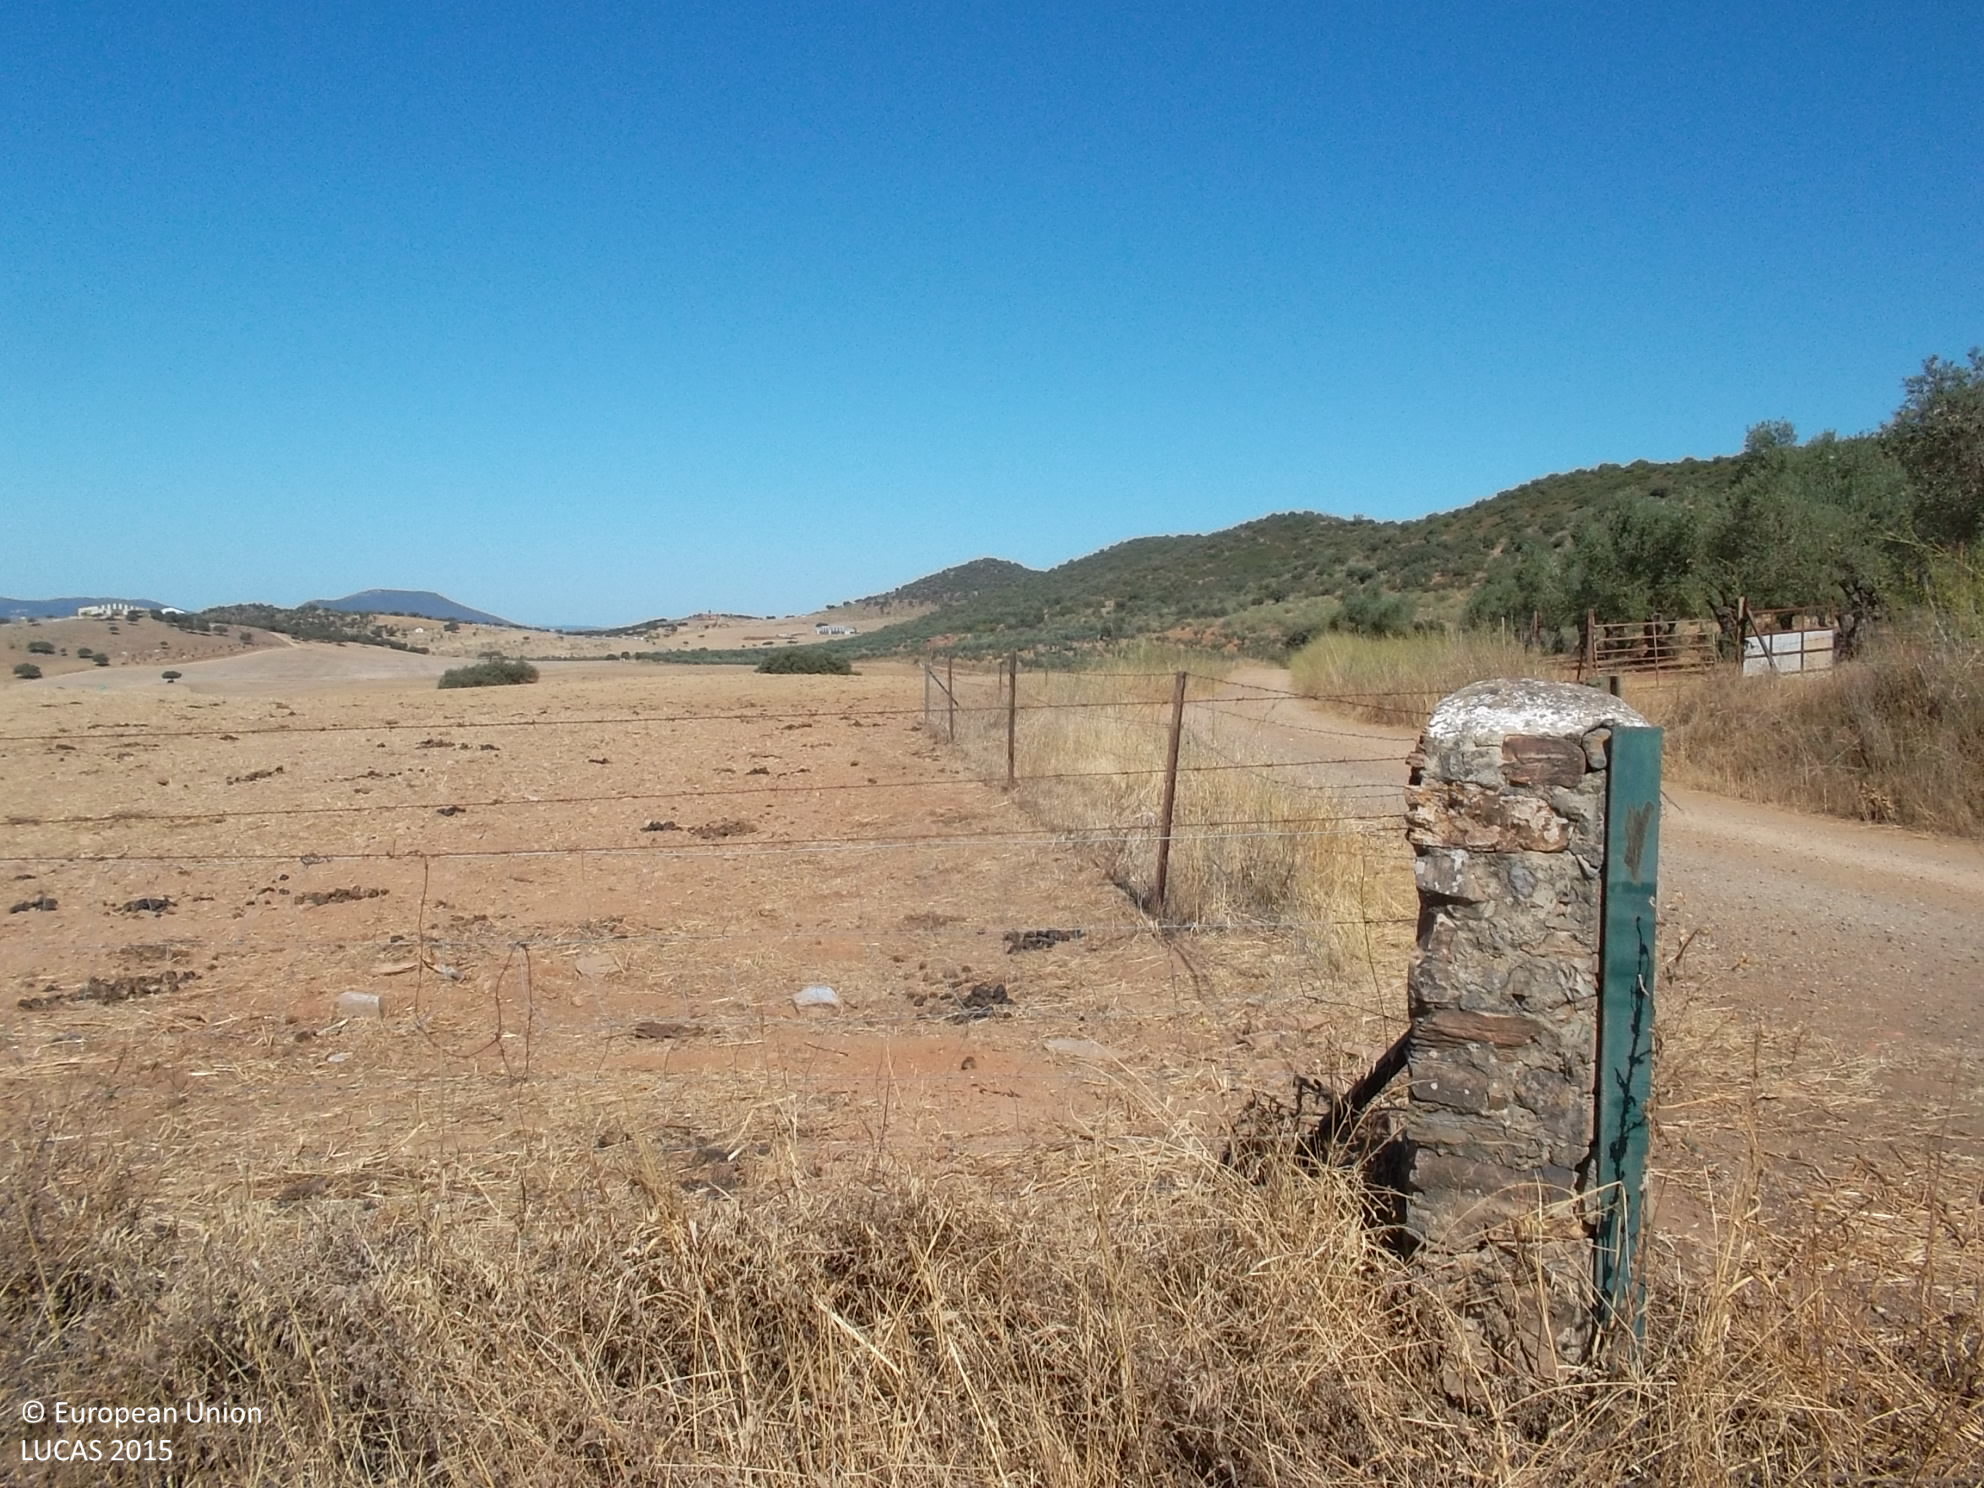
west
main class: Grassland
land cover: Grassland with sparse tree/shrub cover
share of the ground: > 75 %
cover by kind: herbaceous plants 90 %, broadleaved forest trees 5 %, shrubs 5 %
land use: Agriculture (excluding fallow land and kitchen gardens)
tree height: < 5 m
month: August
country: ES
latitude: 38.5194
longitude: -6.6530
